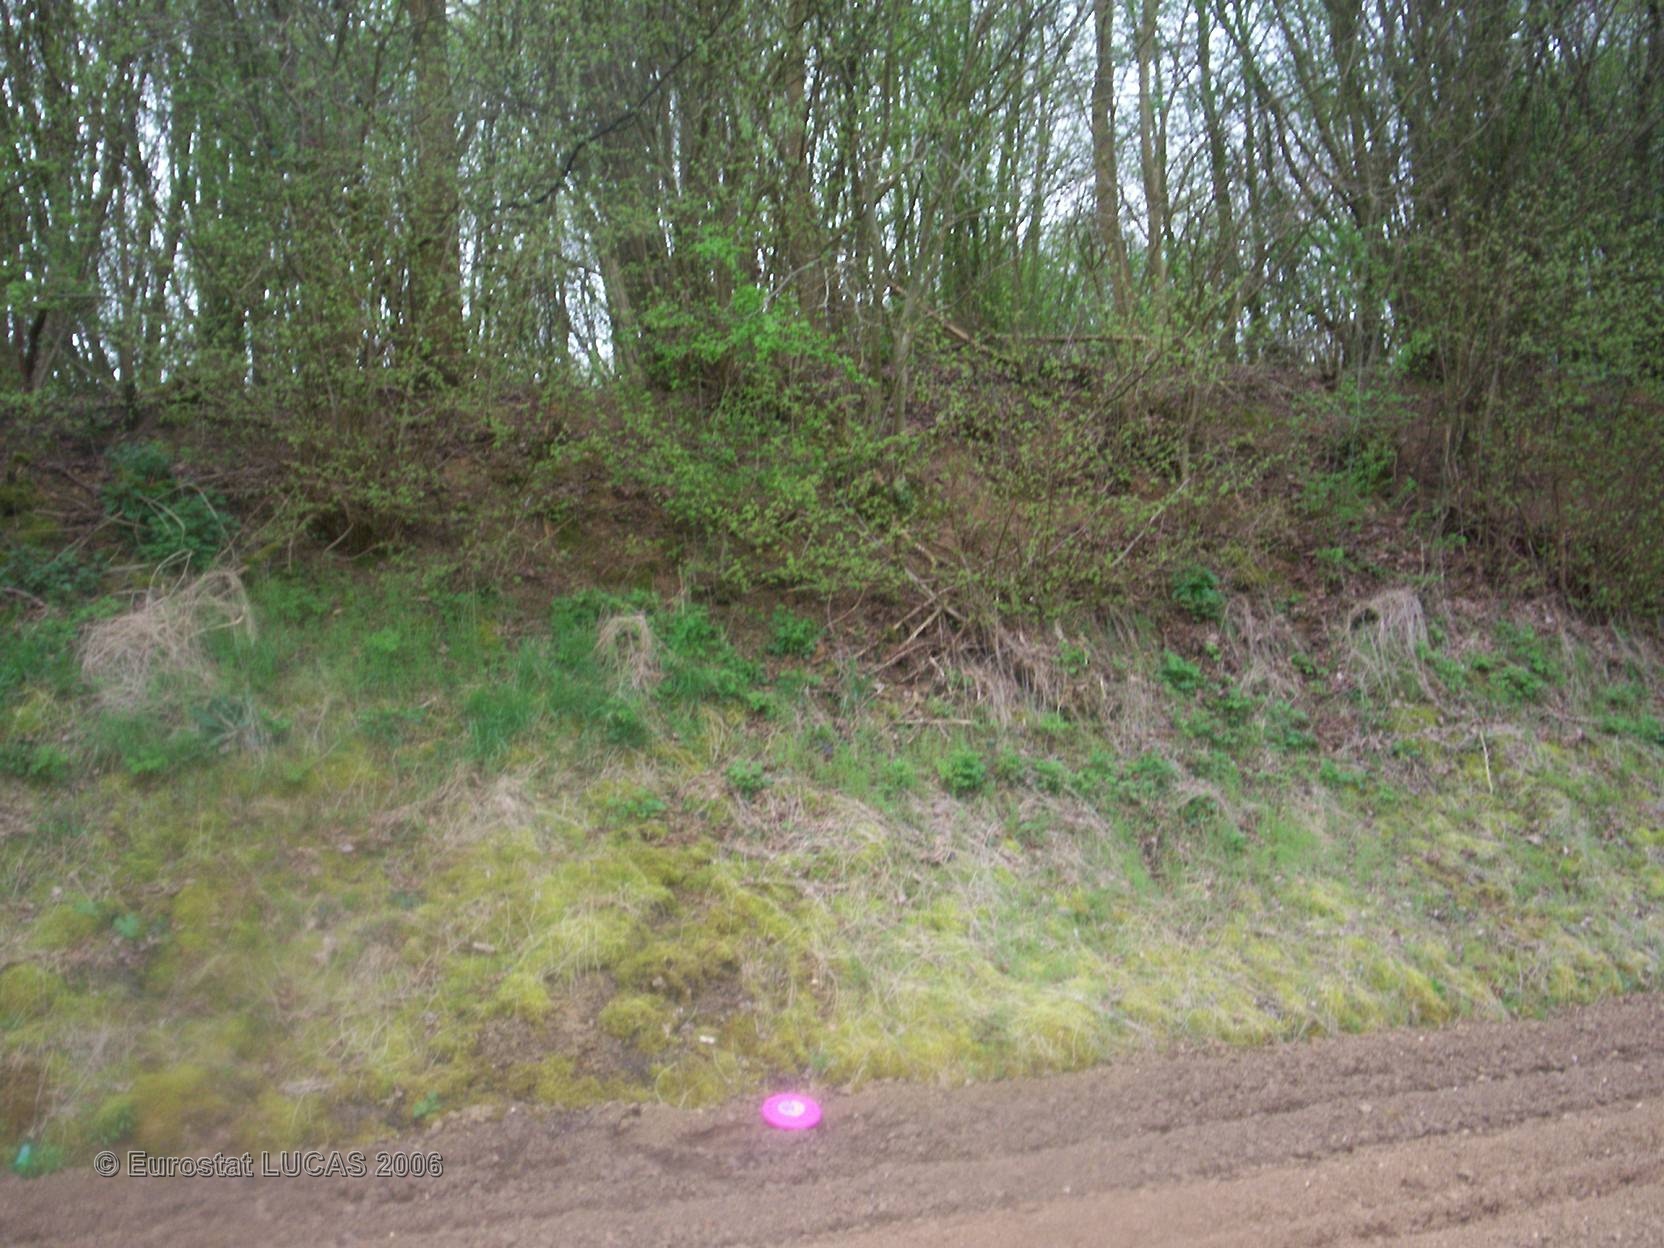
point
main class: Cropland
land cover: Potatoes
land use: Agriculture (excluding fallow land and kitchen gardens)
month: April
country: FR
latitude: 49.9787
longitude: 2.5833
